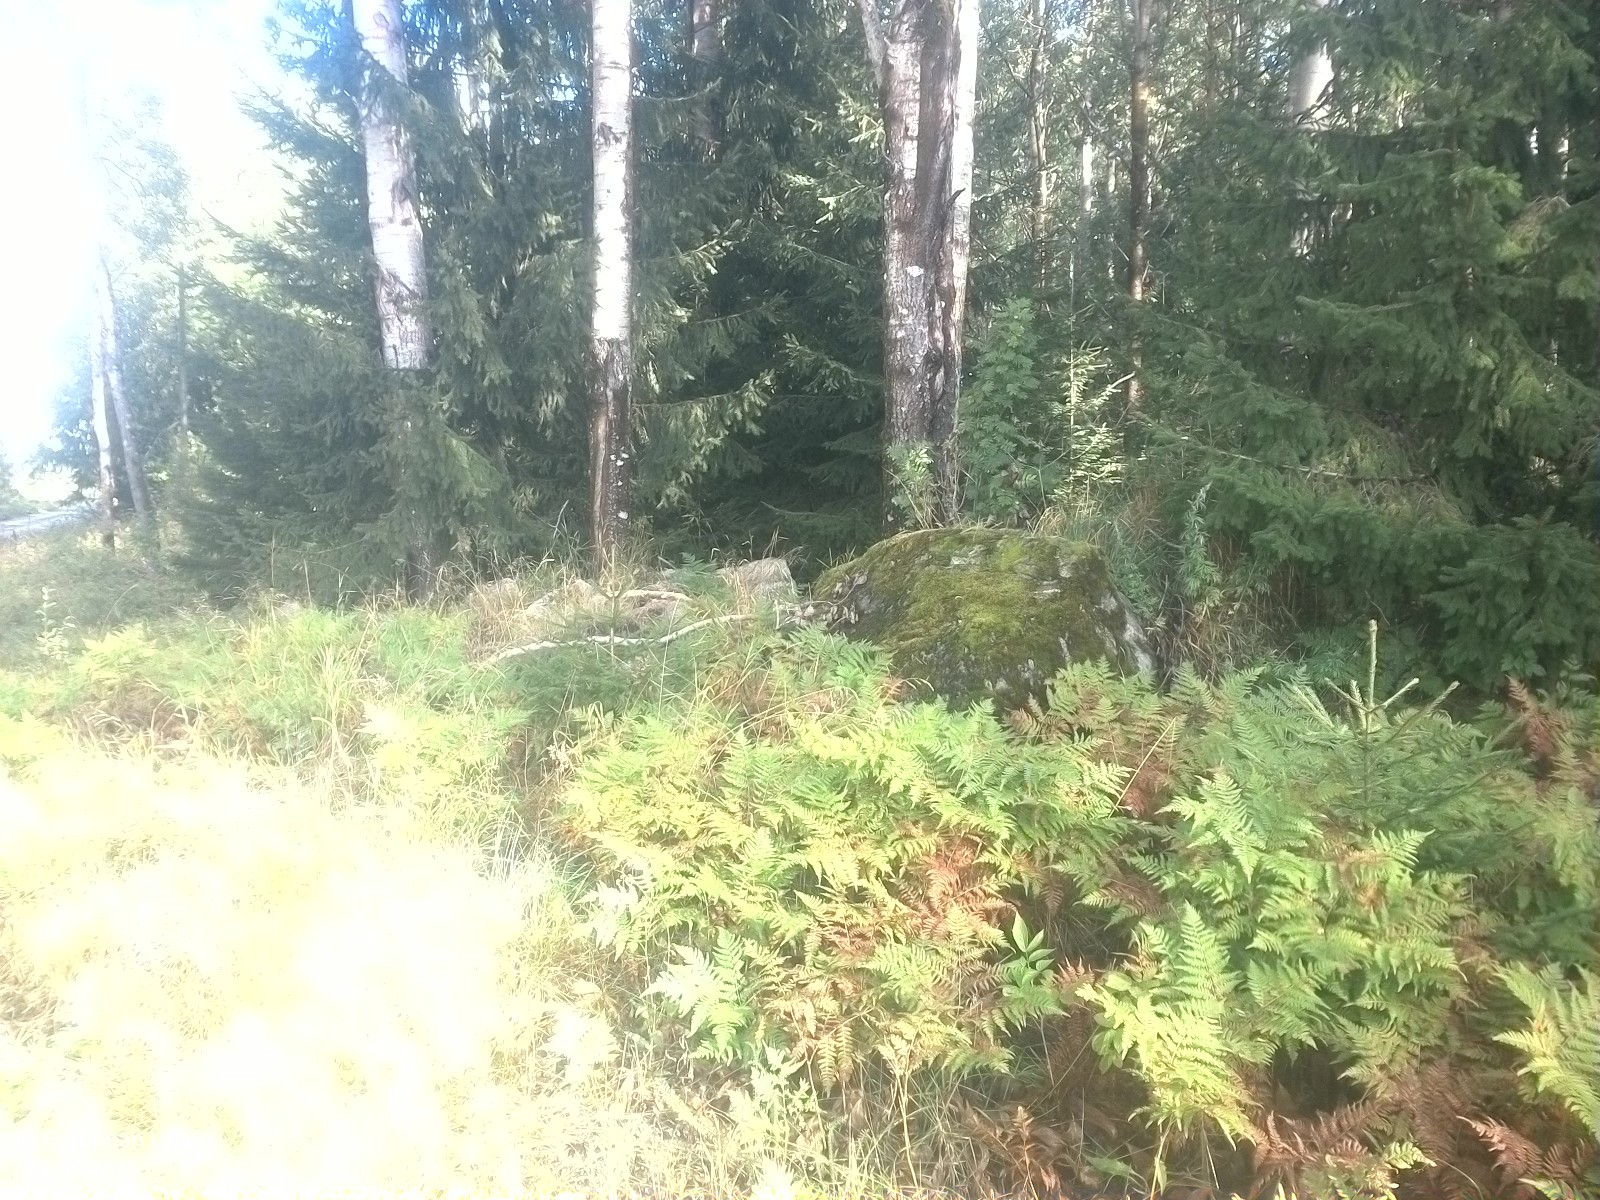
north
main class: Grassland
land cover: Spontaneously vegetated surfaces
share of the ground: > 75 %
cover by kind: herbaceous plants 100 %
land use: Semi-natural and natural areas not in use
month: September
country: SE
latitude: 59.3597
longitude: 15.7442
